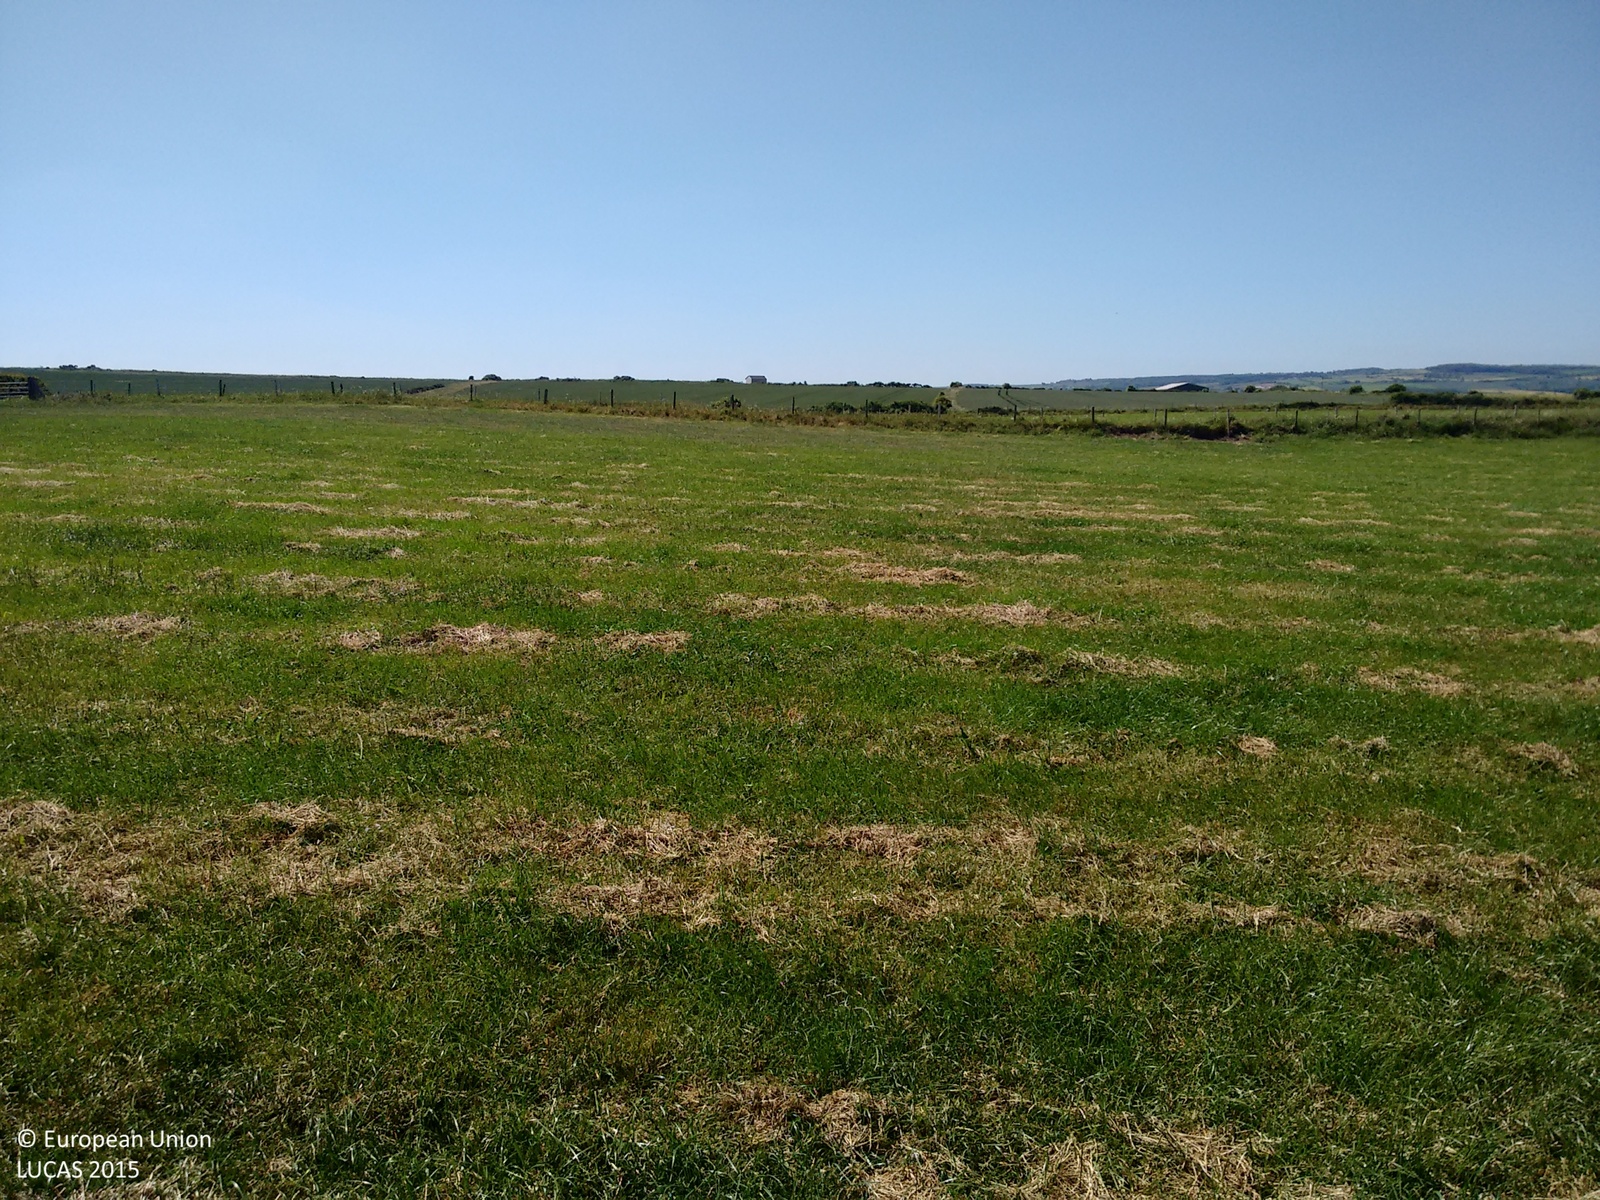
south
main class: Cropland
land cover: Temporary grasslands
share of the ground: > 75 %
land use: Agriculture (excluding fallow land and kitchen gardens)
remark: Harvested field
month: June
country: GB
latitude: 54.4792
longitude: -0.5777
